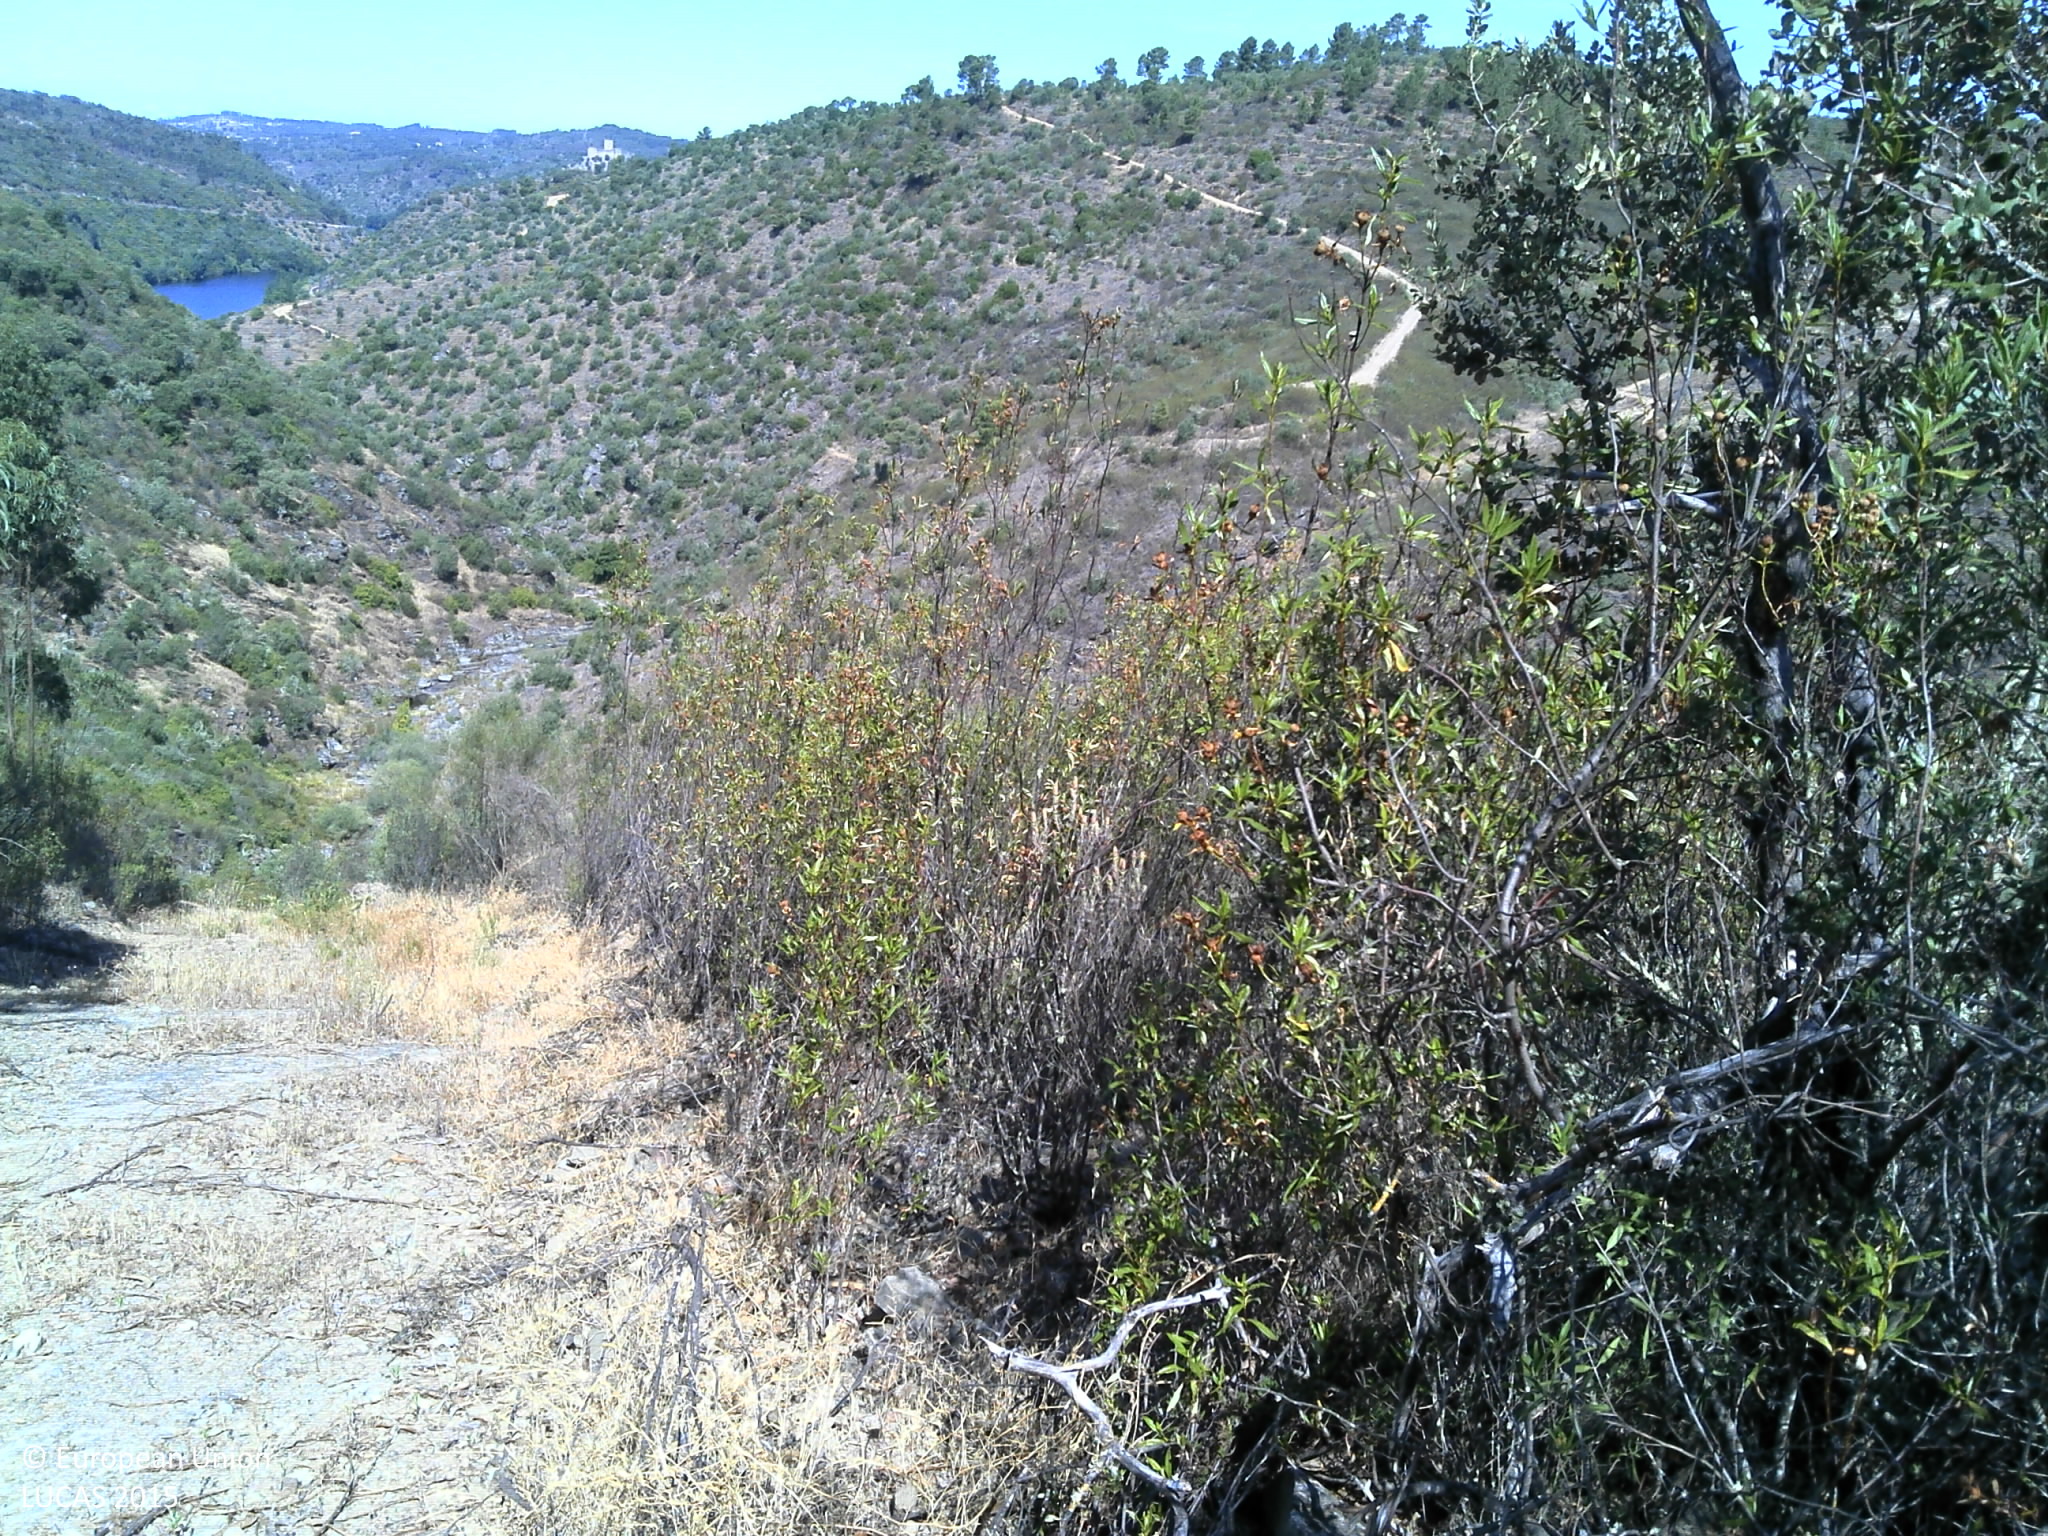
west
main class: Shrubland
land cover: Shrubland without tree cover
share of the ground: 50 - 75 %
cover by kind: shrubs 75 %, unconsolidated bare surface 25 %
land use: Semi-natural and natural areas not in use
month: July
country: PT
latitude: 39.4877
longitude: -7.9277
